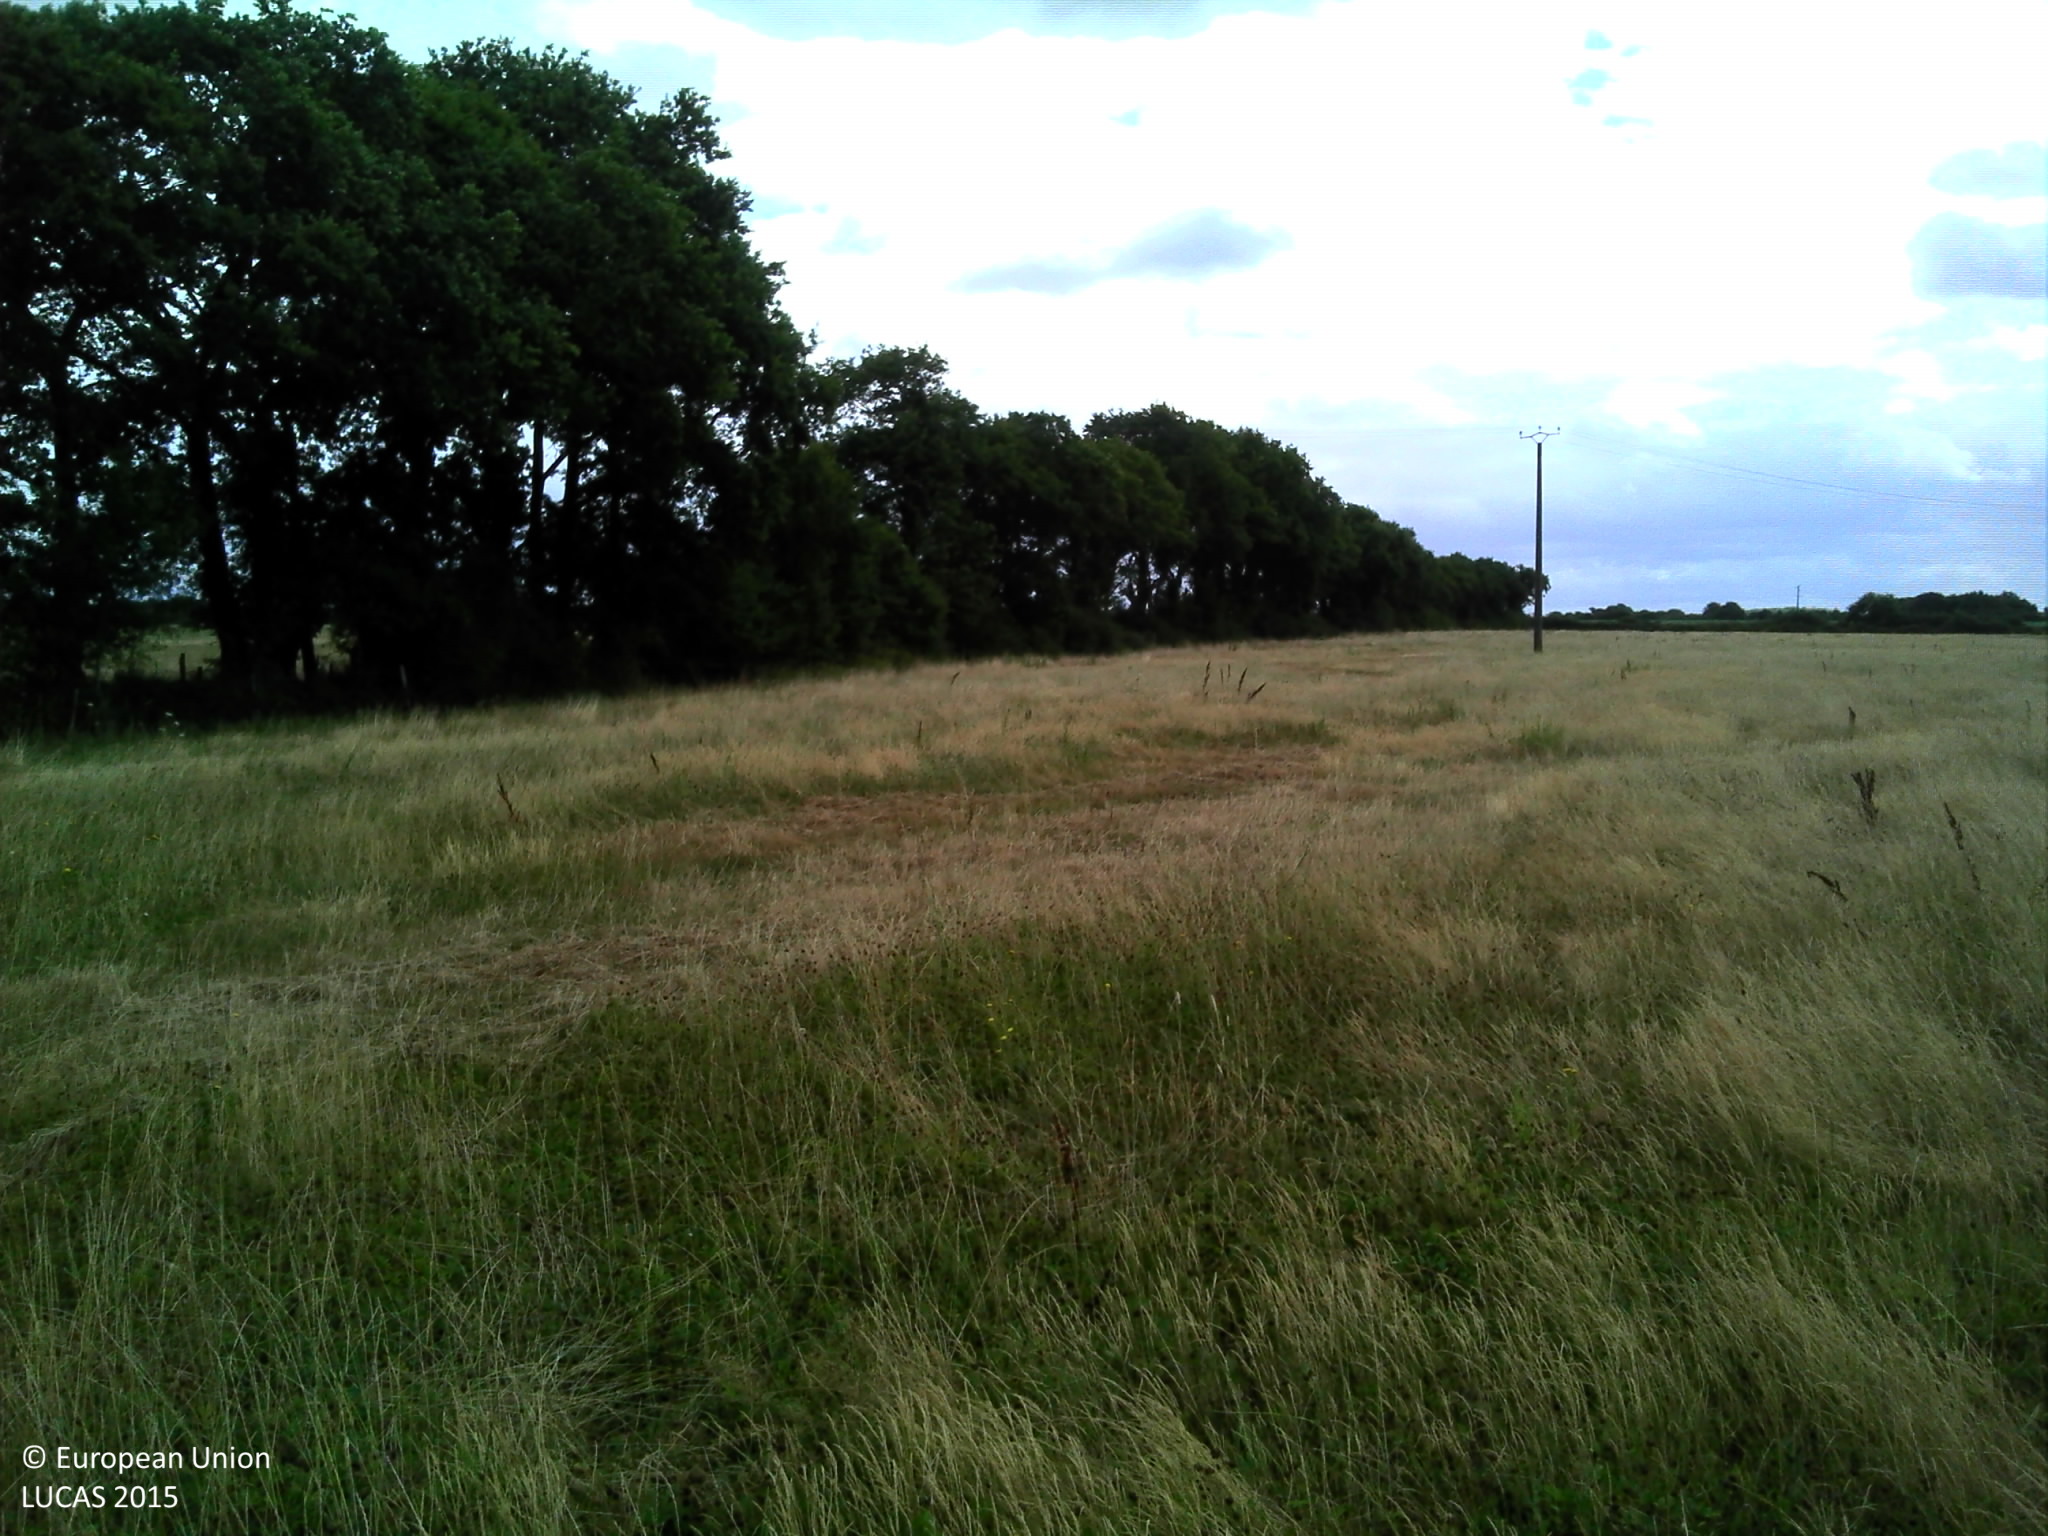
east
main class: Cropland
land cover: Temporary grasslands
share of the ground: > 75 %
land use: Agriculture (excluding fallow land and kitchen gardens)
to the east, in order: Temporary grasslands; Electric lines; Temporary grasslands; Fences; Broadleaved woodland; Fences; Grassland without tree/shrub cover; Fences; Grassland without tree/shrub cover
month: July
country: FR
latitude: 47.4500
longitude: -1.8914
